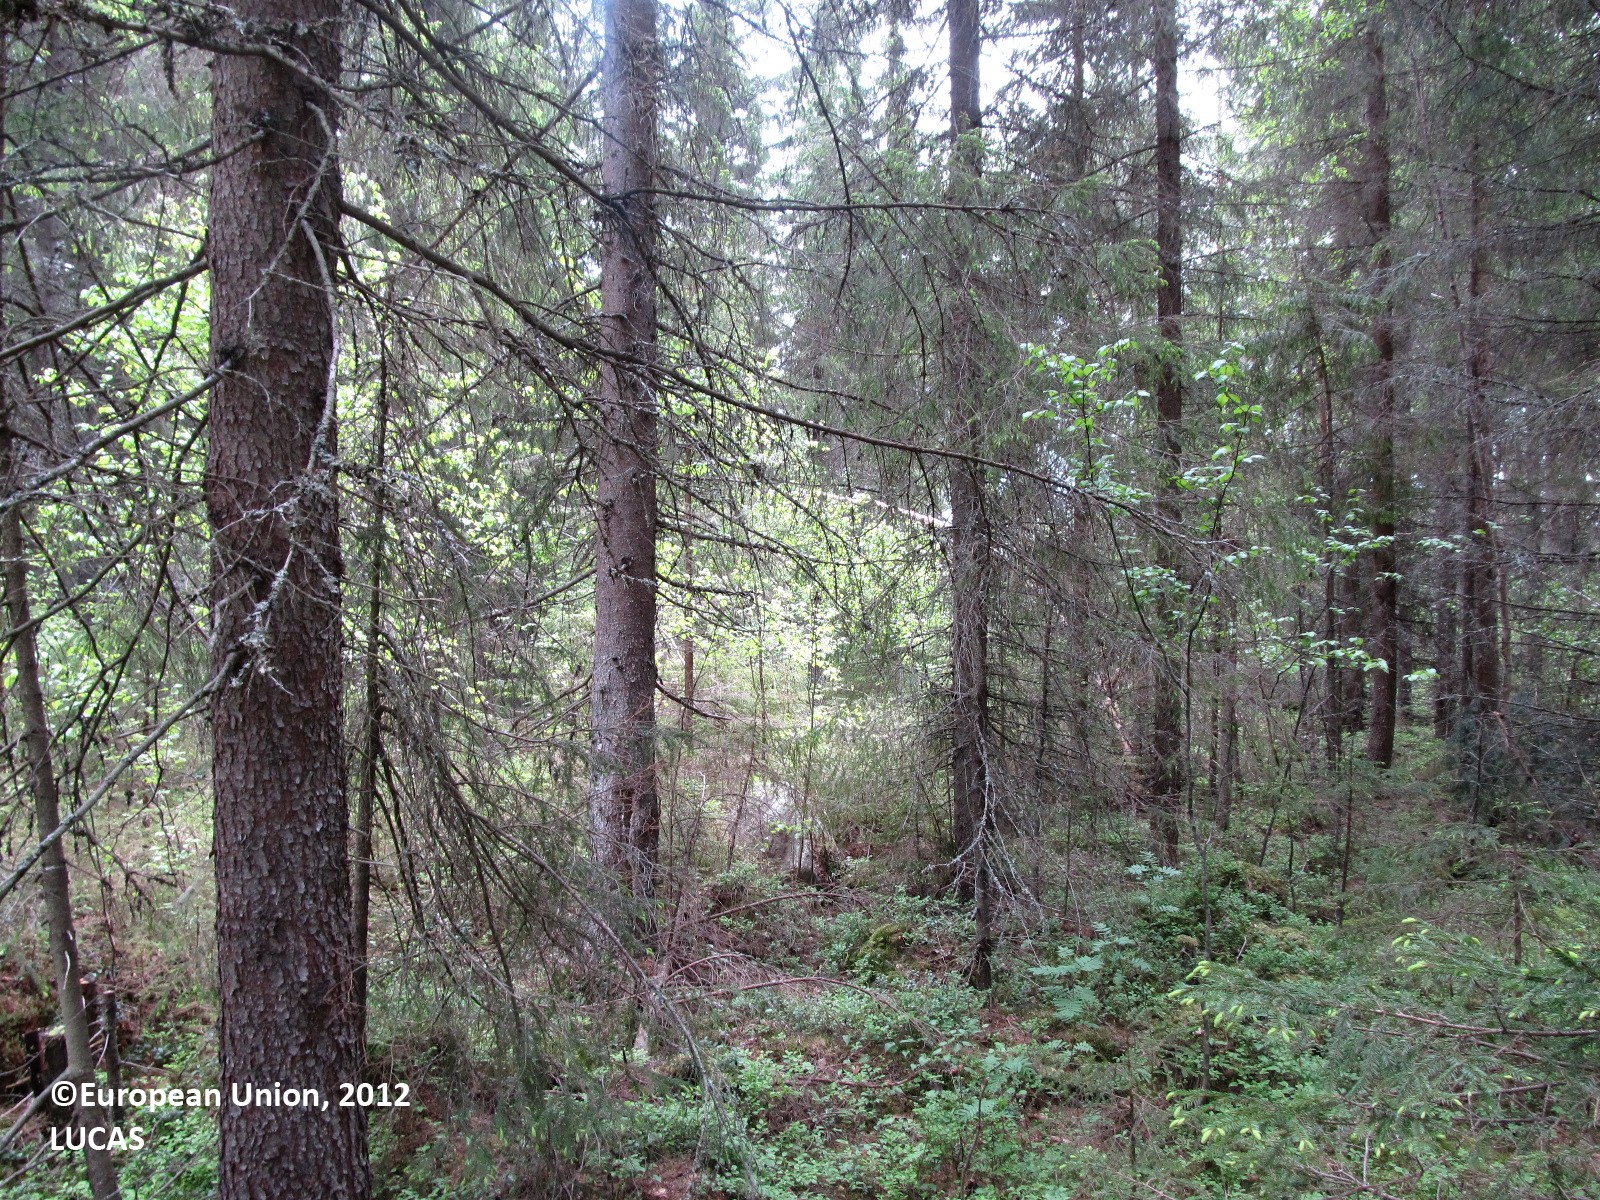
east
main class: Woodland
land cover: Spruce dominated coniferous woodland
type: boreal forest
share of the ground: 25 - 50 %
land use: Forestry
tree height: > 5 m
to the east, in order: Spruce dominated coniferous woodland; Ditches and canals; Spruce dominated coniferous woodland; Ditches and canals; Spruce dominated coniferous woodland; Other bare soil; Spruce dominated coniferous woodland; Other bare soil; Spruce dominated coniferous woodland; Grassland without tree/shrub cover; Spruce dominated coniferous woodland
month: June
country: FI
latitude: 62.5361
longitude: 29.1763
